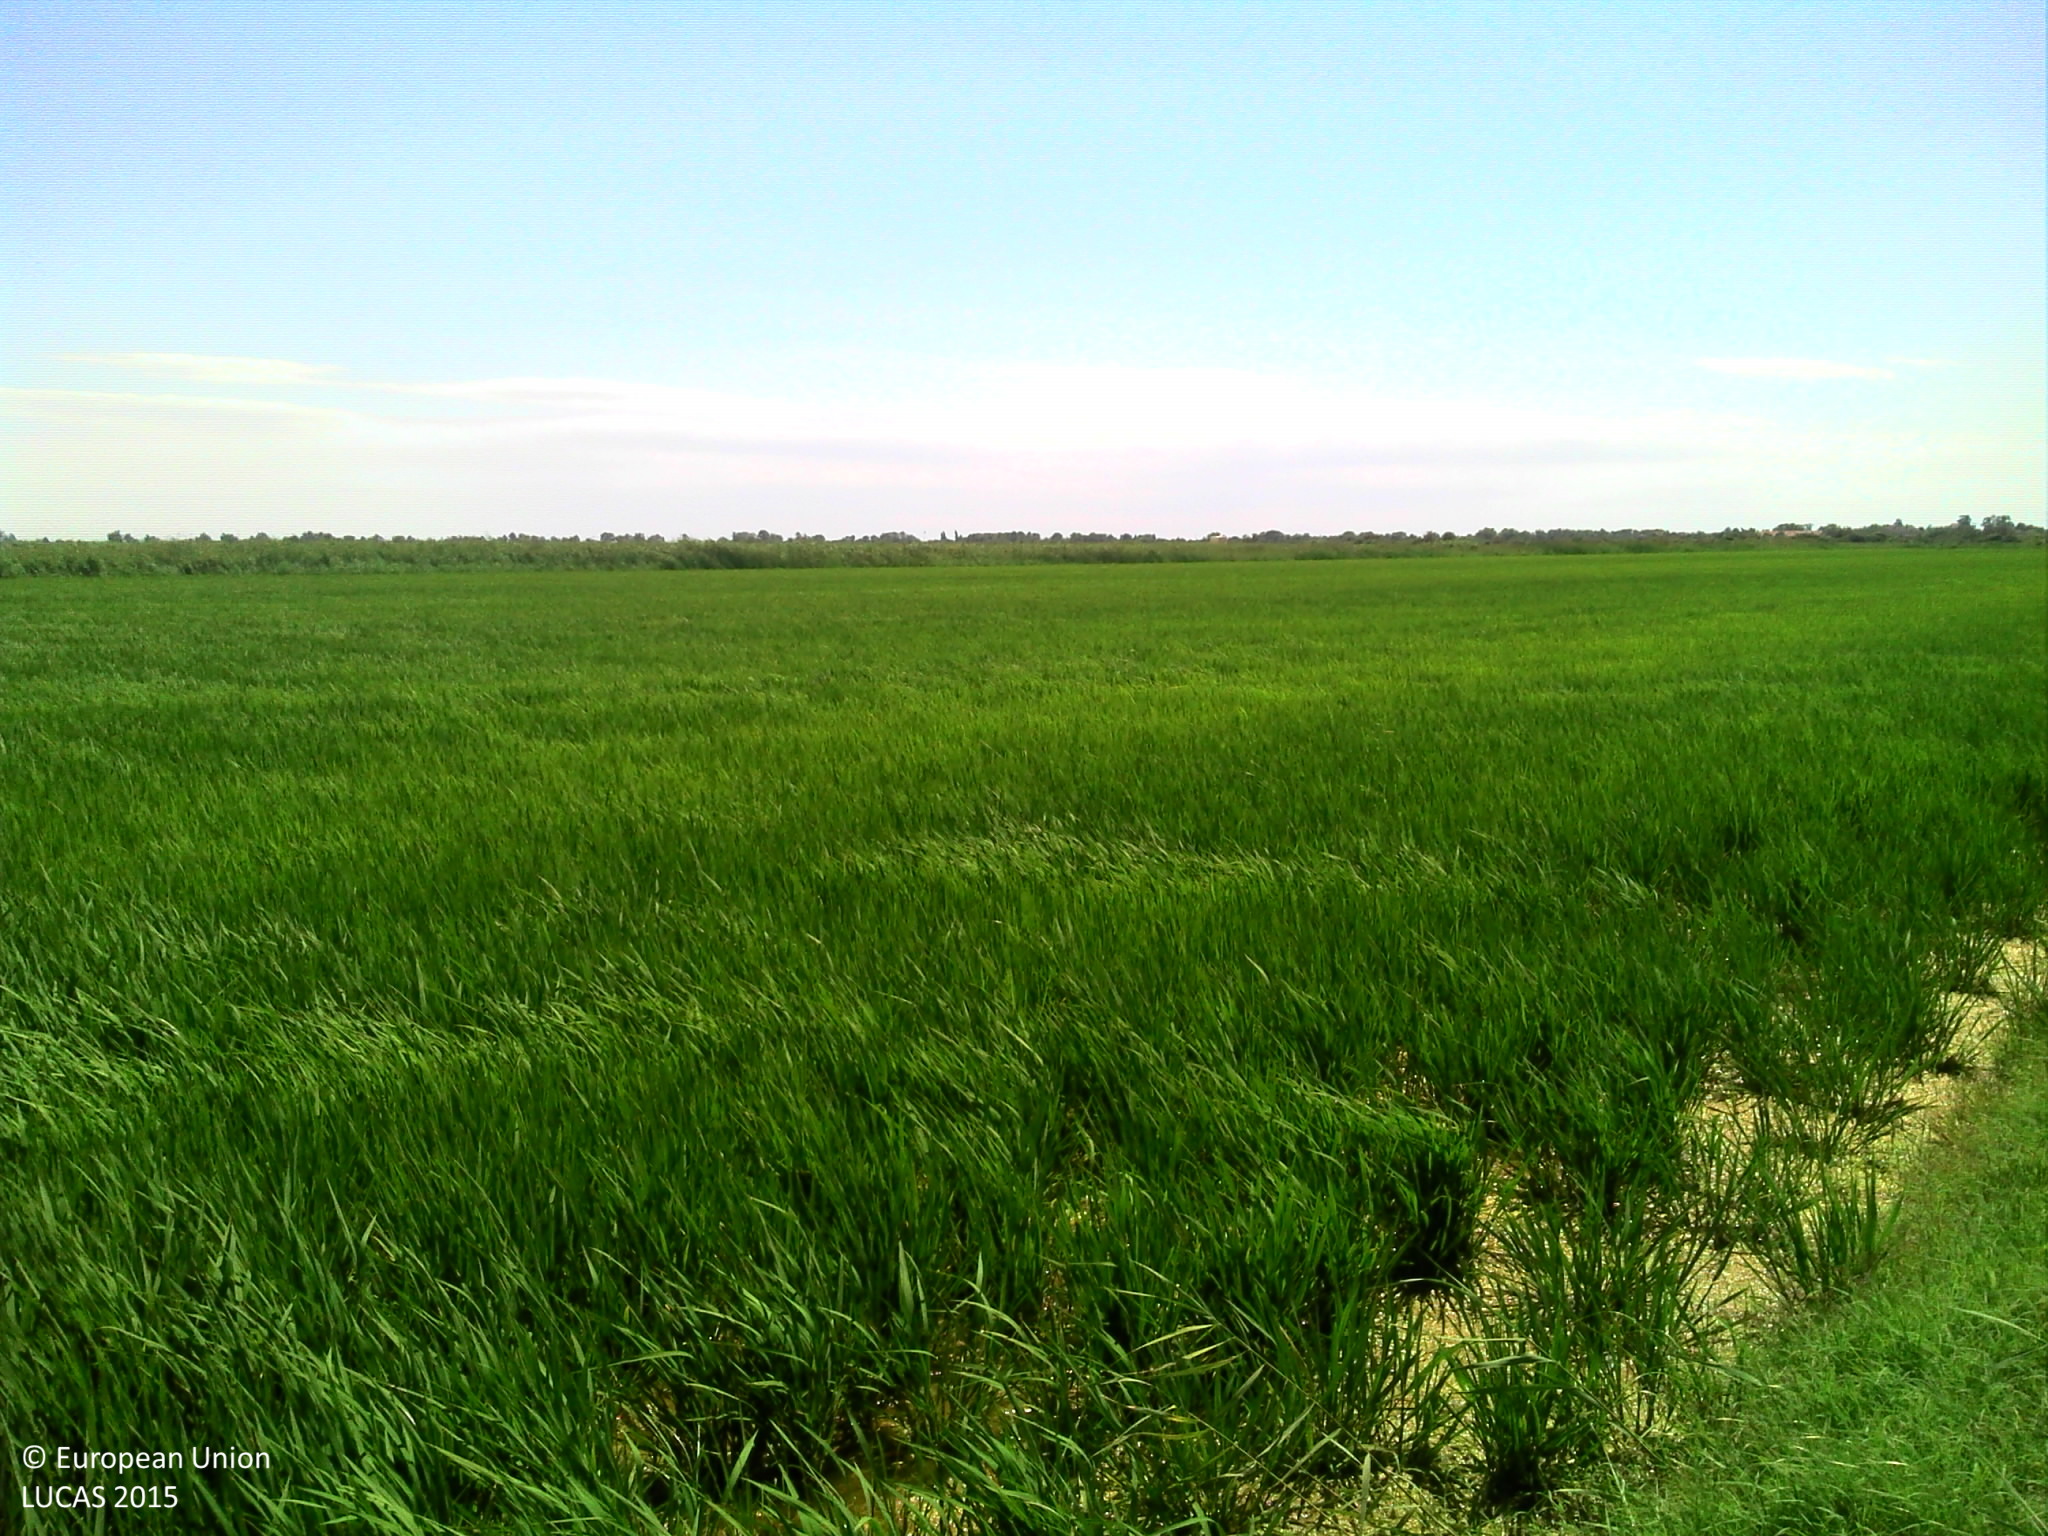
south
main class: Cropland
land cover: Rice
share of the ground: > 75 %
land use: Agriculture (excluding fallow land and kitchen gardens)
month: July
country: FR
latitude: 43.4203
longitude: 4.7116
